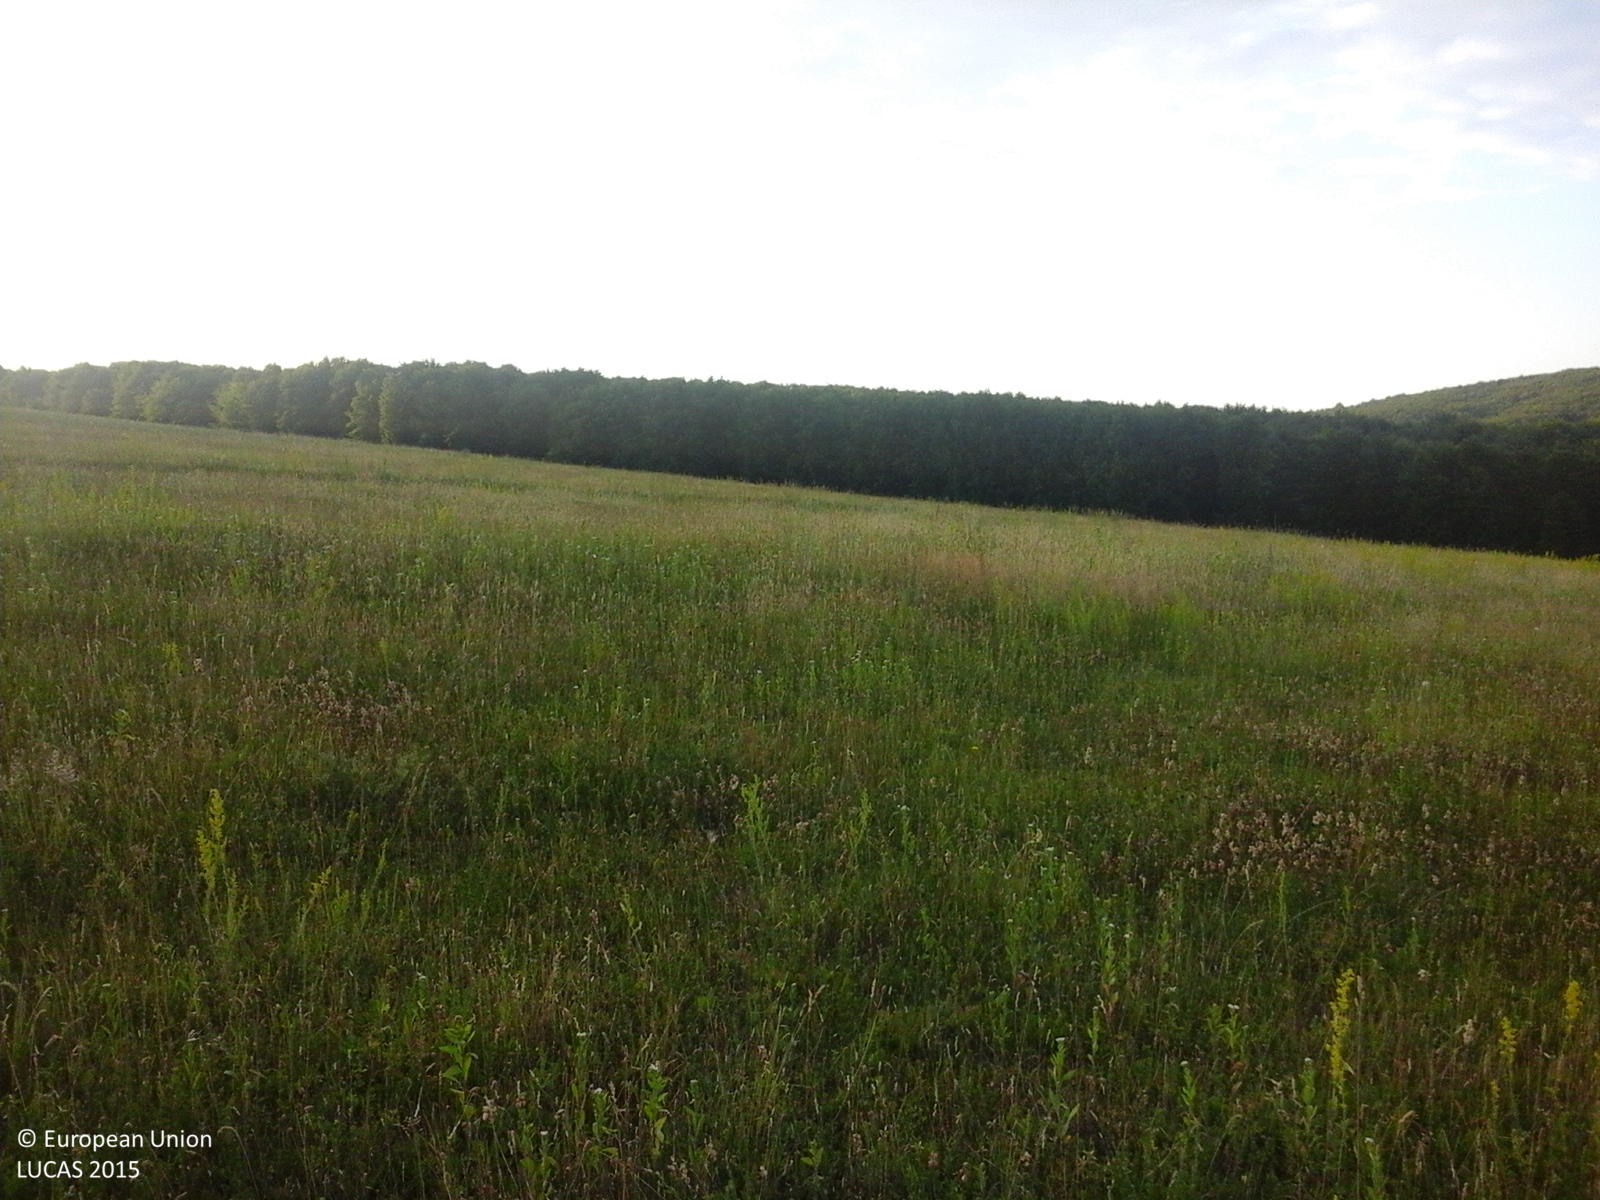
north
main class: Grassland
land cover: Grassland without tree/shrub cover
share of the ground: > 75 %
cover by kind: herbaceous plants 100 %
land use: Agriculture (excluding fallow land and kitchen gardens)
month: June
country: RO
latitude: 47.4607
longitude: 26.5251
